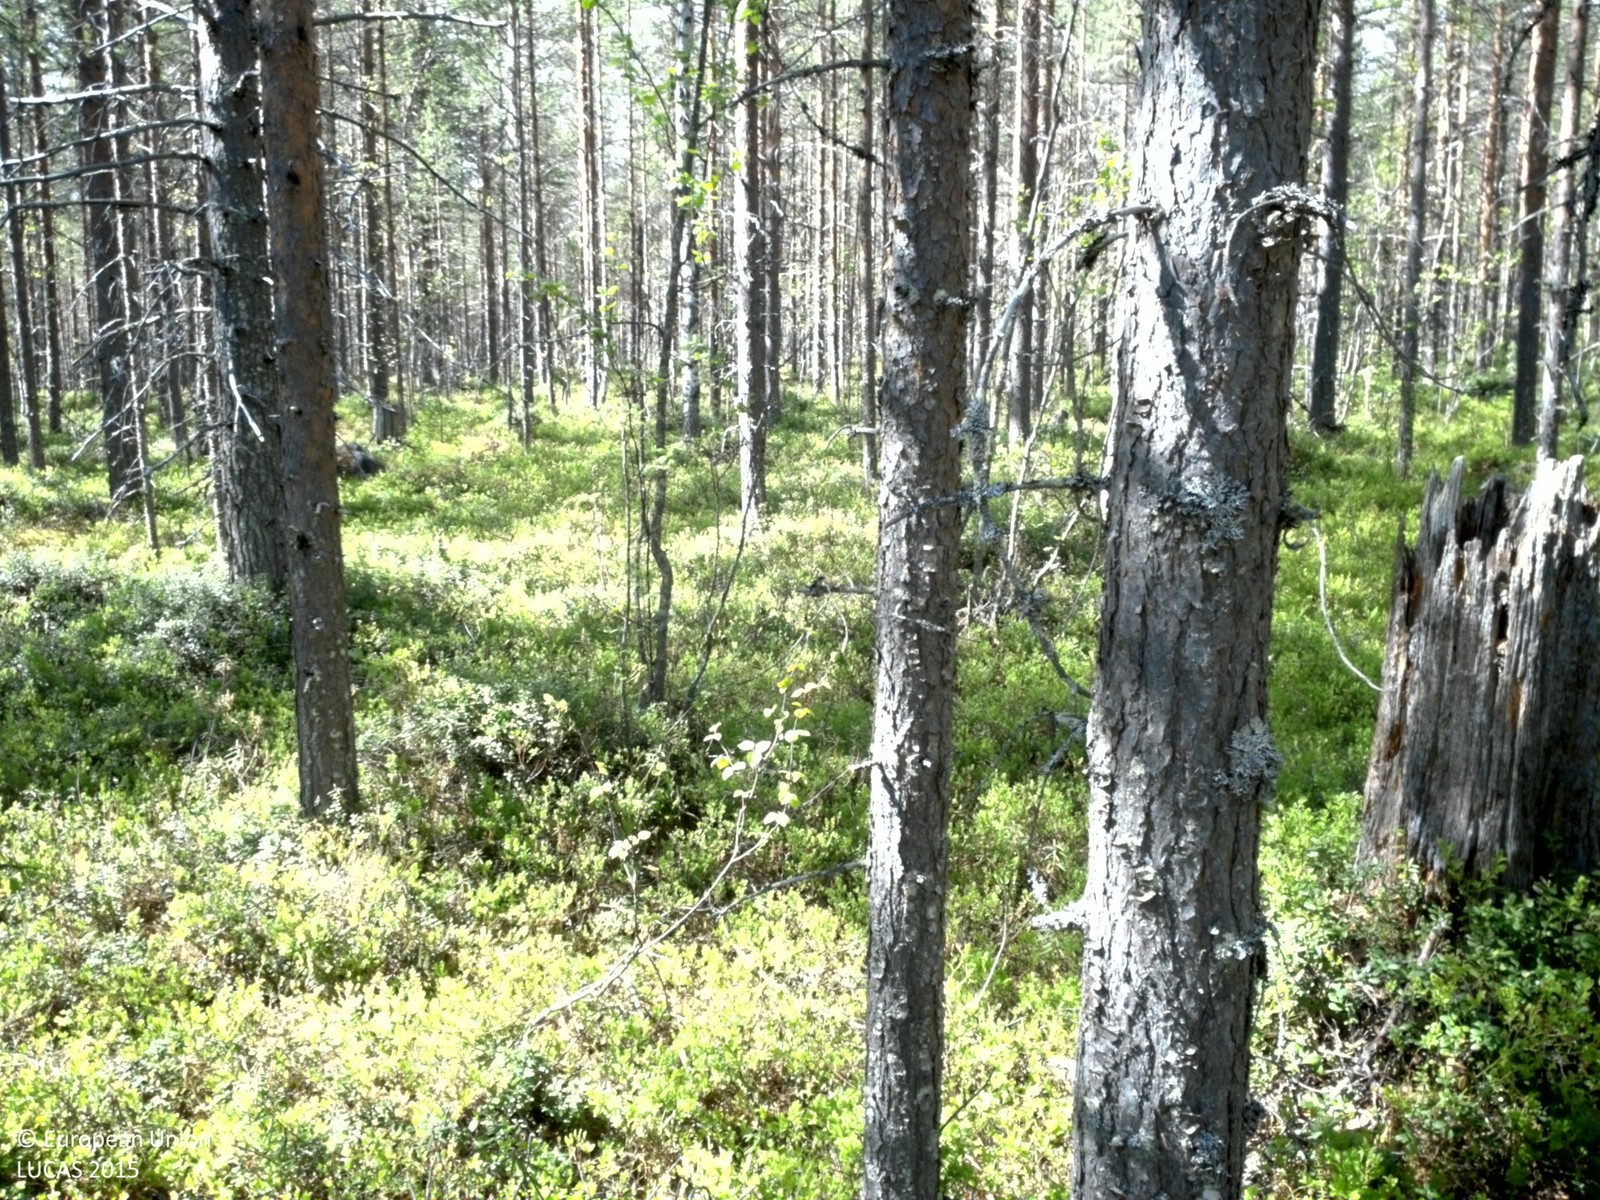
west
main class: Woodland
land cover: Pine dominated coniferous woodland
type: boreal forest
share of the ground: 50 - 75 %
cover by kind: coniferous forest trees 60 %, shrubs 30 %, broadleaved forest trees 10 %
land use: Forestry
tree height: > 5 m
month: June
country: SE
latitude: 66.5925
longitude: 22.3531
